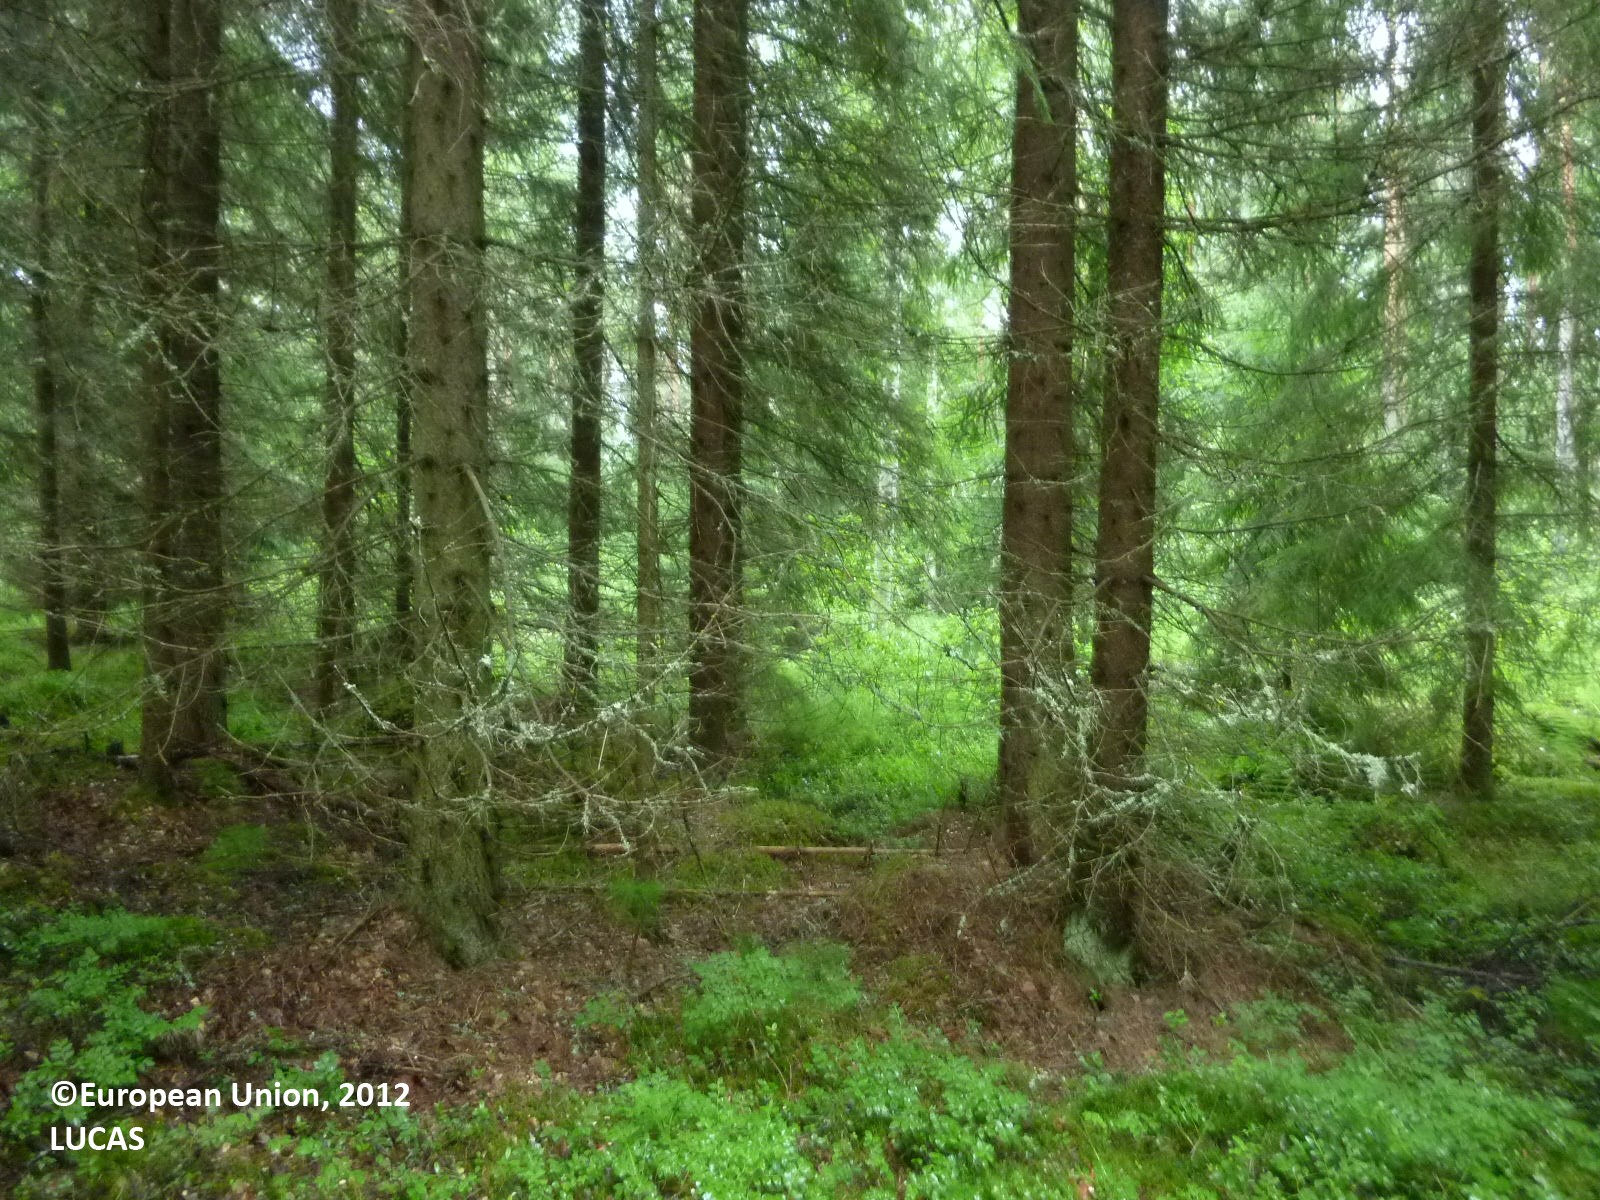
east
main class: Woodland
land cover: Spruce dominated coniferous woodland
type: boreal forest
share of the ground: > 75 %
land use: Forestry
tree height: > 5 m
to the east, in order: Spruce dominated coniferous woodland; Ditches and canals; Spruce dominated mixed woodland; Pine dominated mixed woodland; Ditches and canals; Pine dominated mixed woodland; Ditches and canals; Broadleaved woodland; Tracks; Spruce dominated coniferous woodland; Pine dominated coniferous woodland; Ditches and canals; Pine dominated mixed woodland; Ditches and canals; Pine dominated mixed woodland
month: July
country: FI
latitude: 61.4502
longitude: 22.2712
